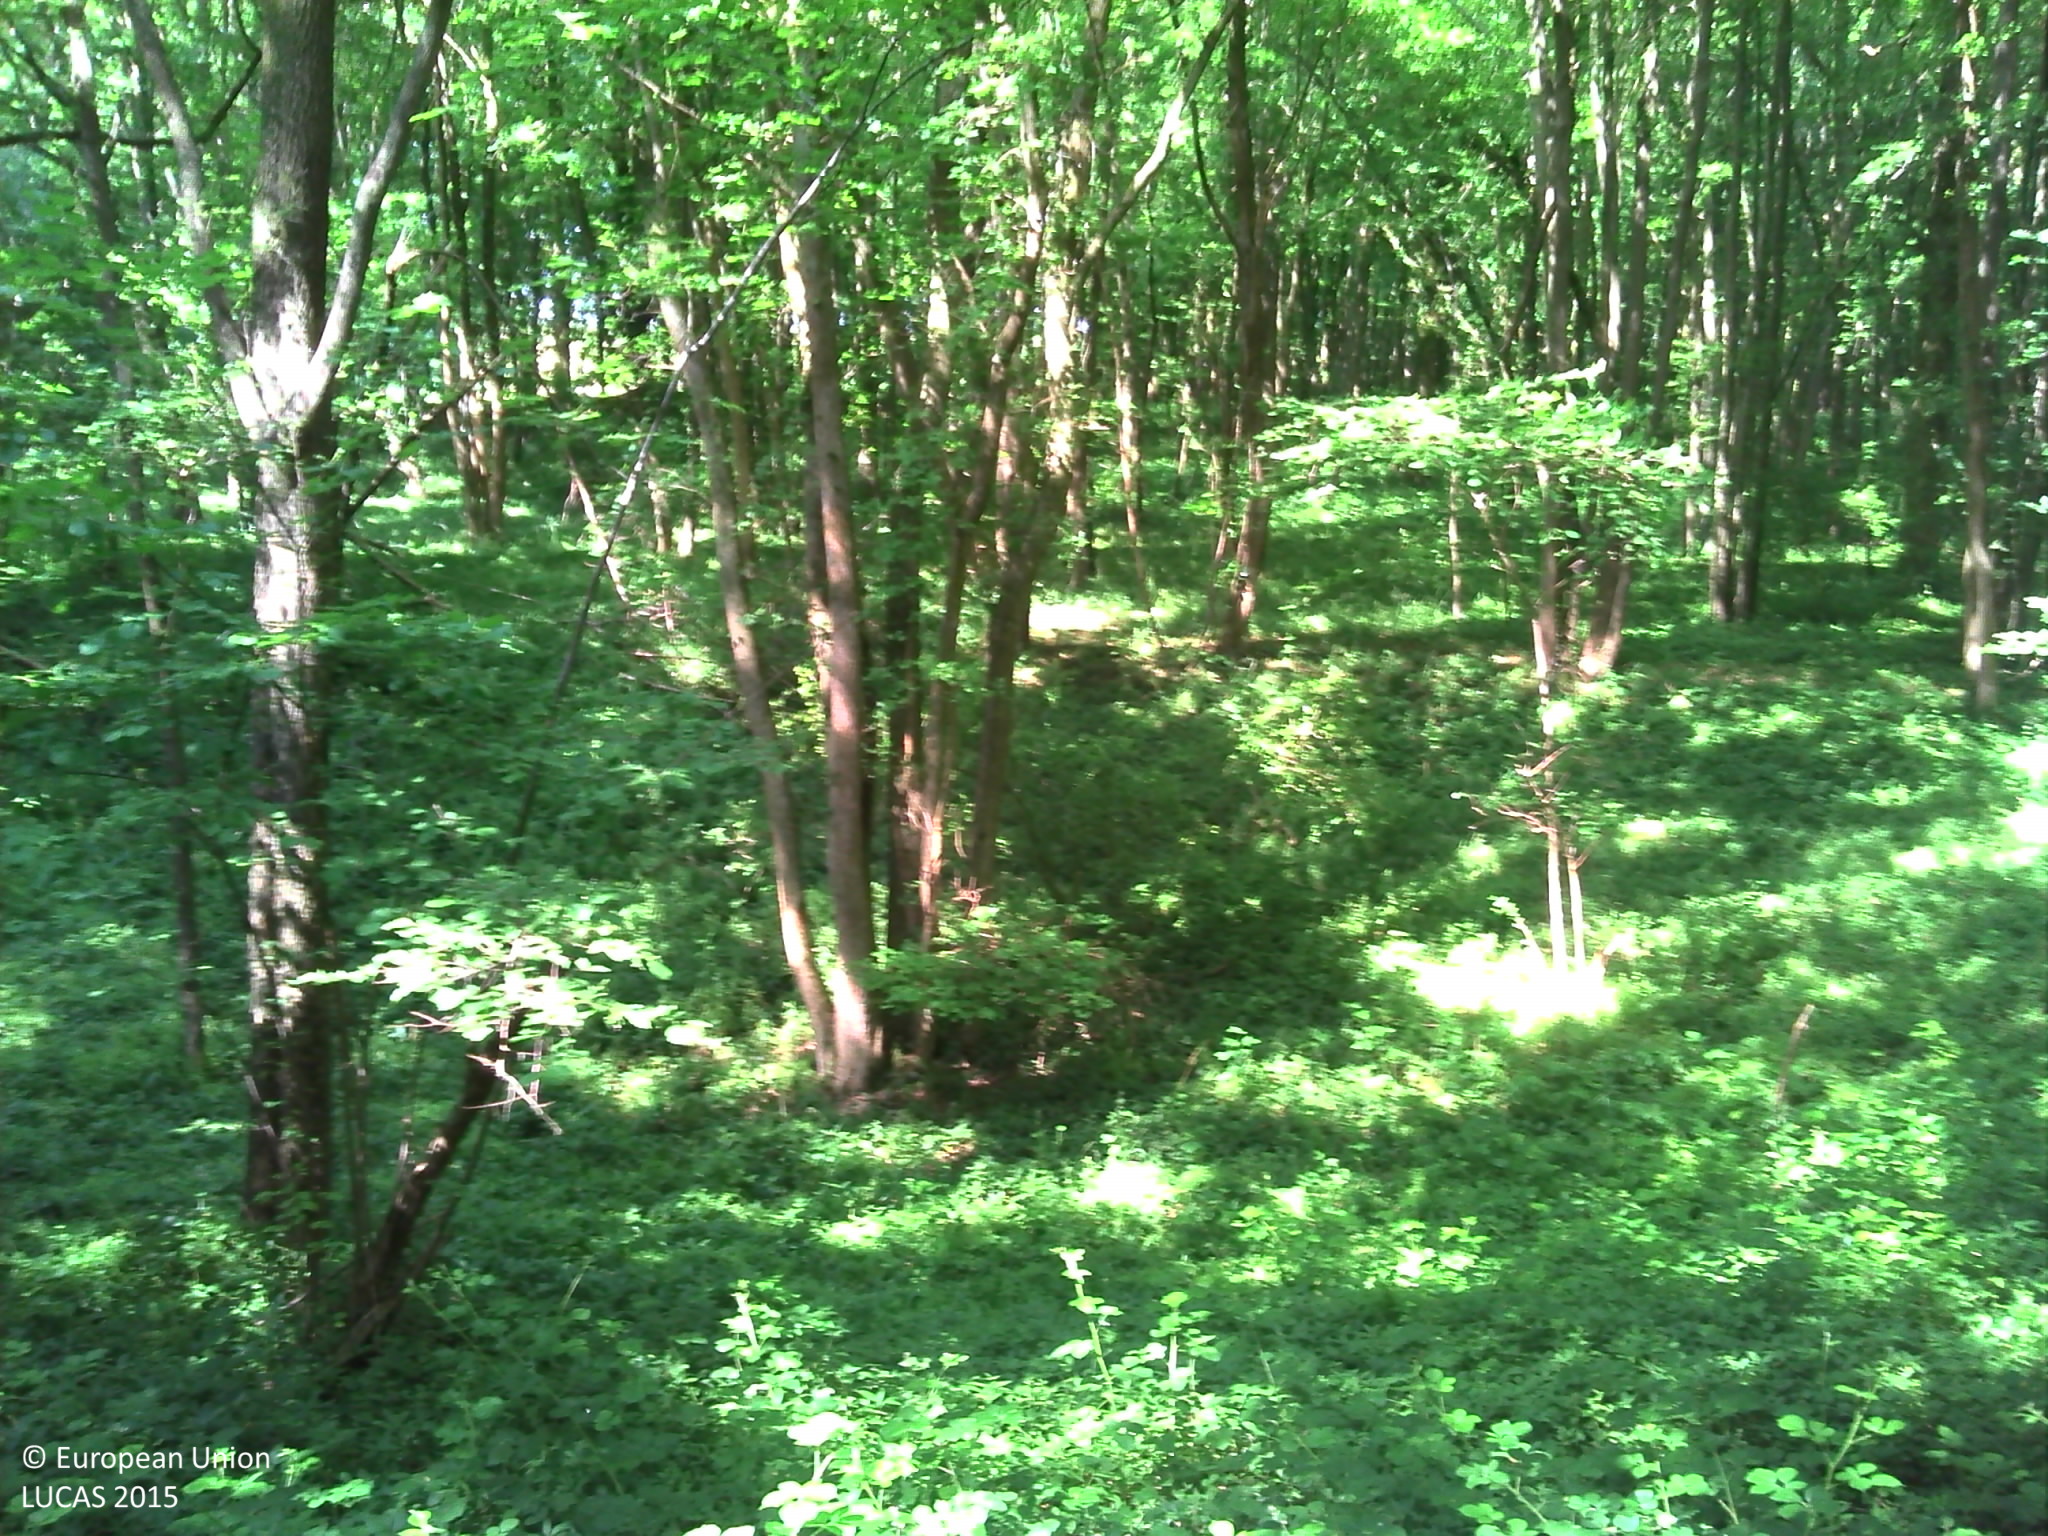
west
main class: Woodland
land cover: Broadleaved woodland
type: mesophytic deciduous forest
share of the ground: > 75 %
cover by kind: broadleaved forest trees 55 %, herbaceous plants 40 %, shrubs 5 %
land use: Forestry
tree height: > 5 m
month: June
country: FR
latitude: 49.5423
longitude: 2.5392
